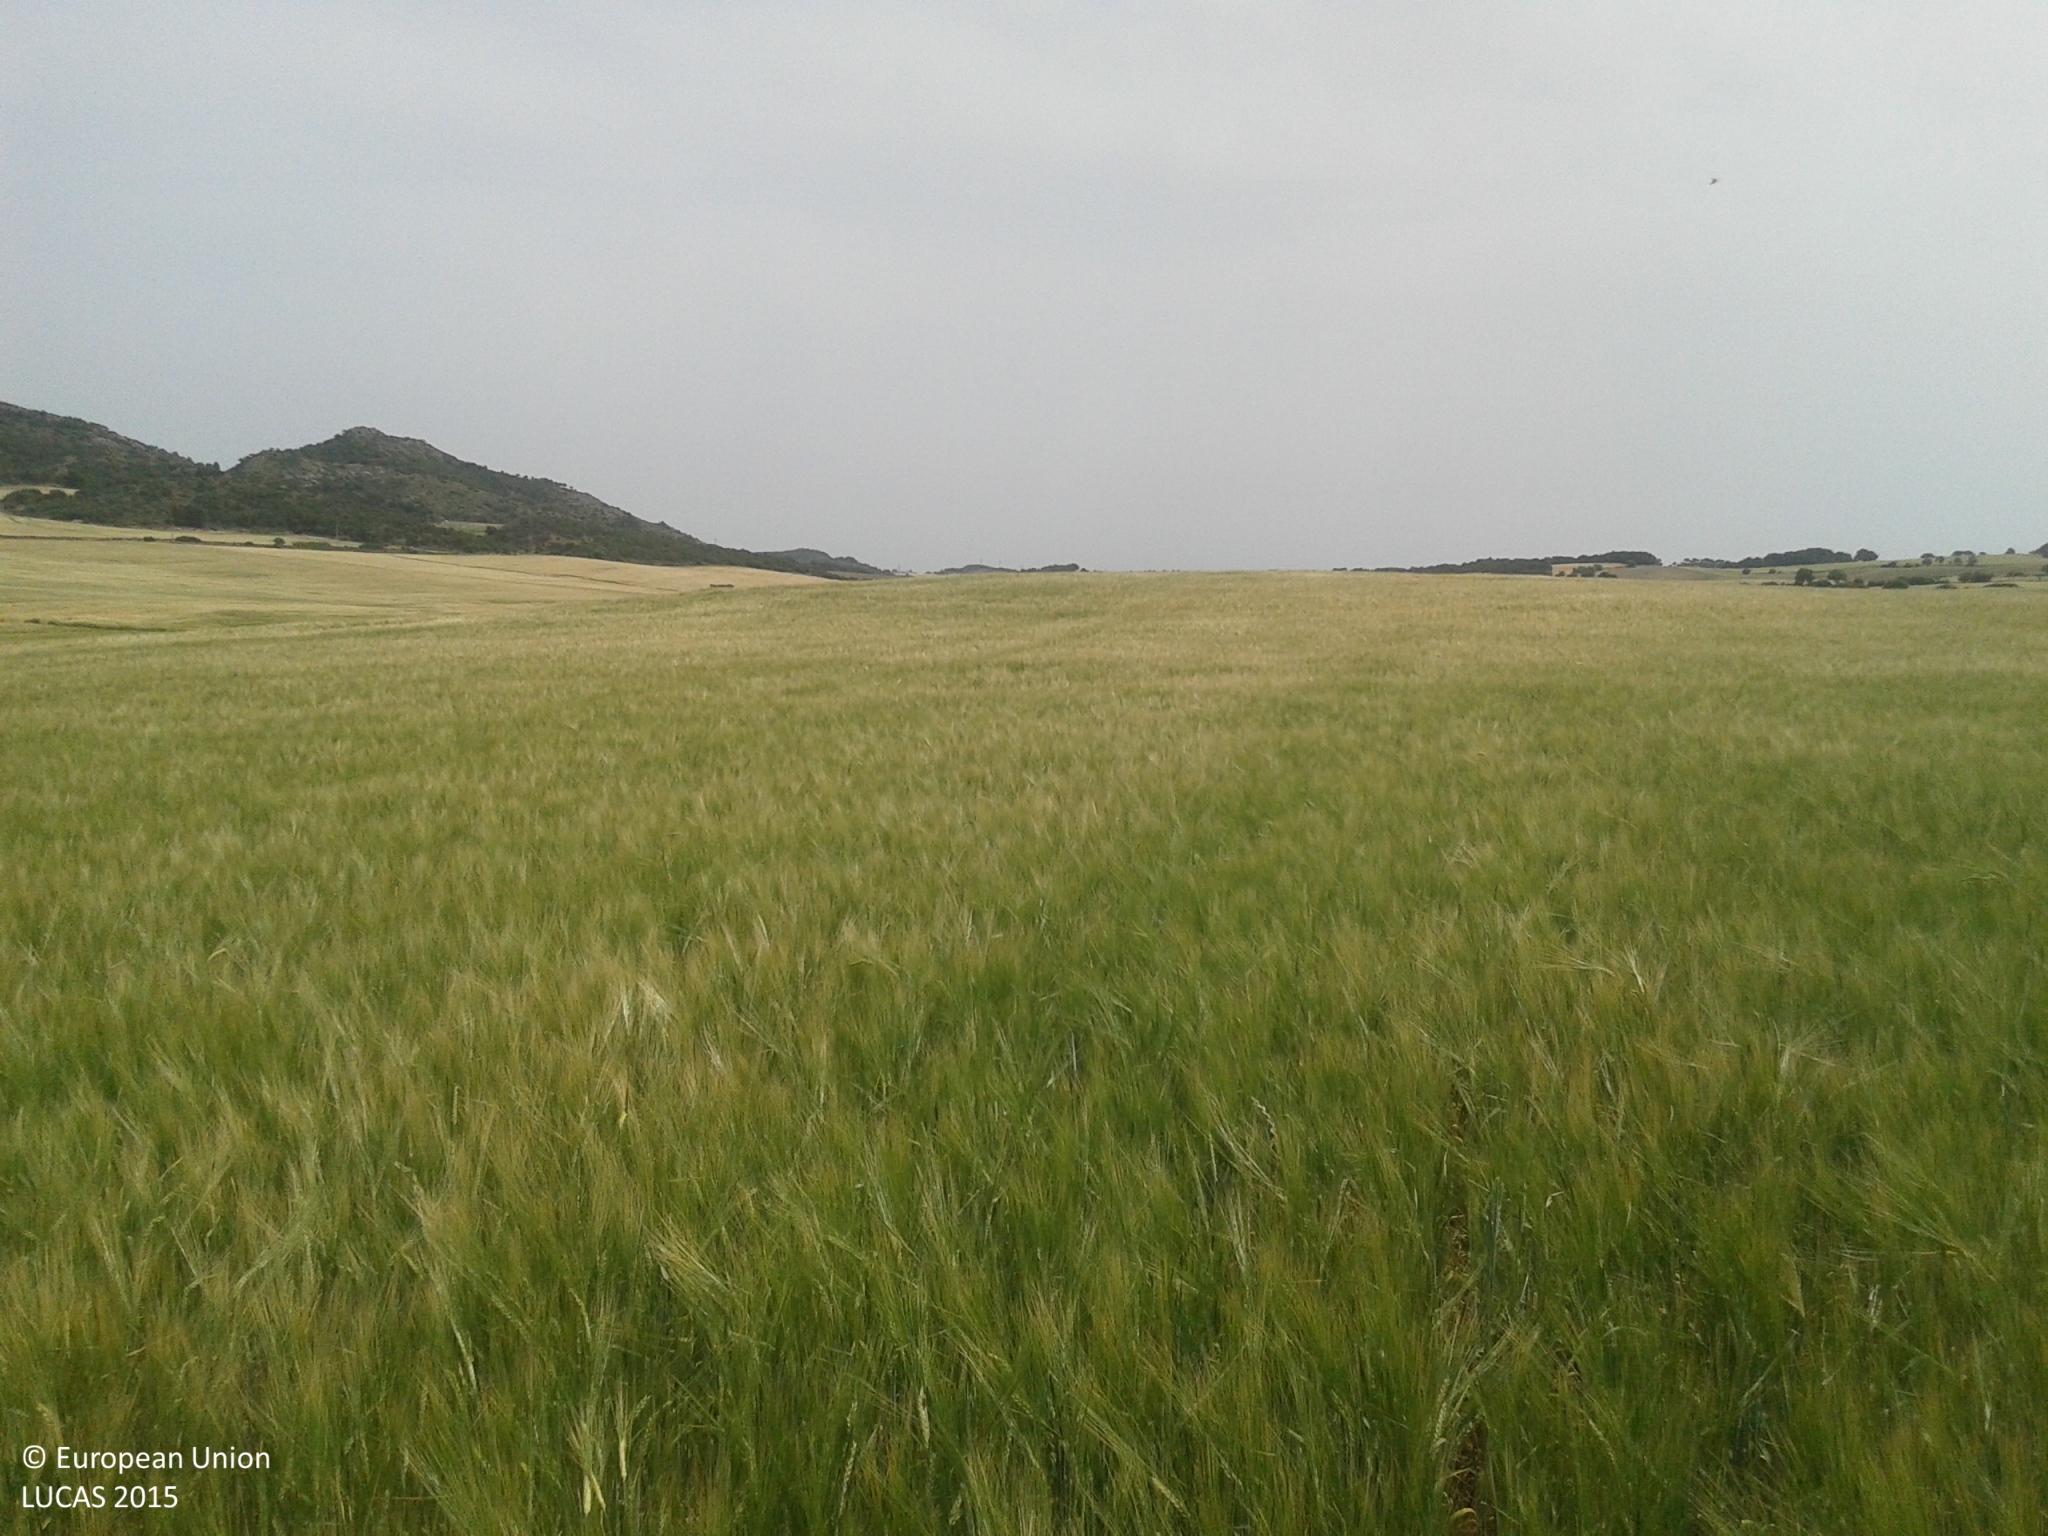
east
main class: Cropland
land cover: Barley
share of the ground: > 75 %
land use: Agriculture (excluding fallow land and kitchen gardens)
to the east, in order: Barley; Tracks; Barley
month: May
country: ES
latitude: 41.8237
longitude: 0.6797
